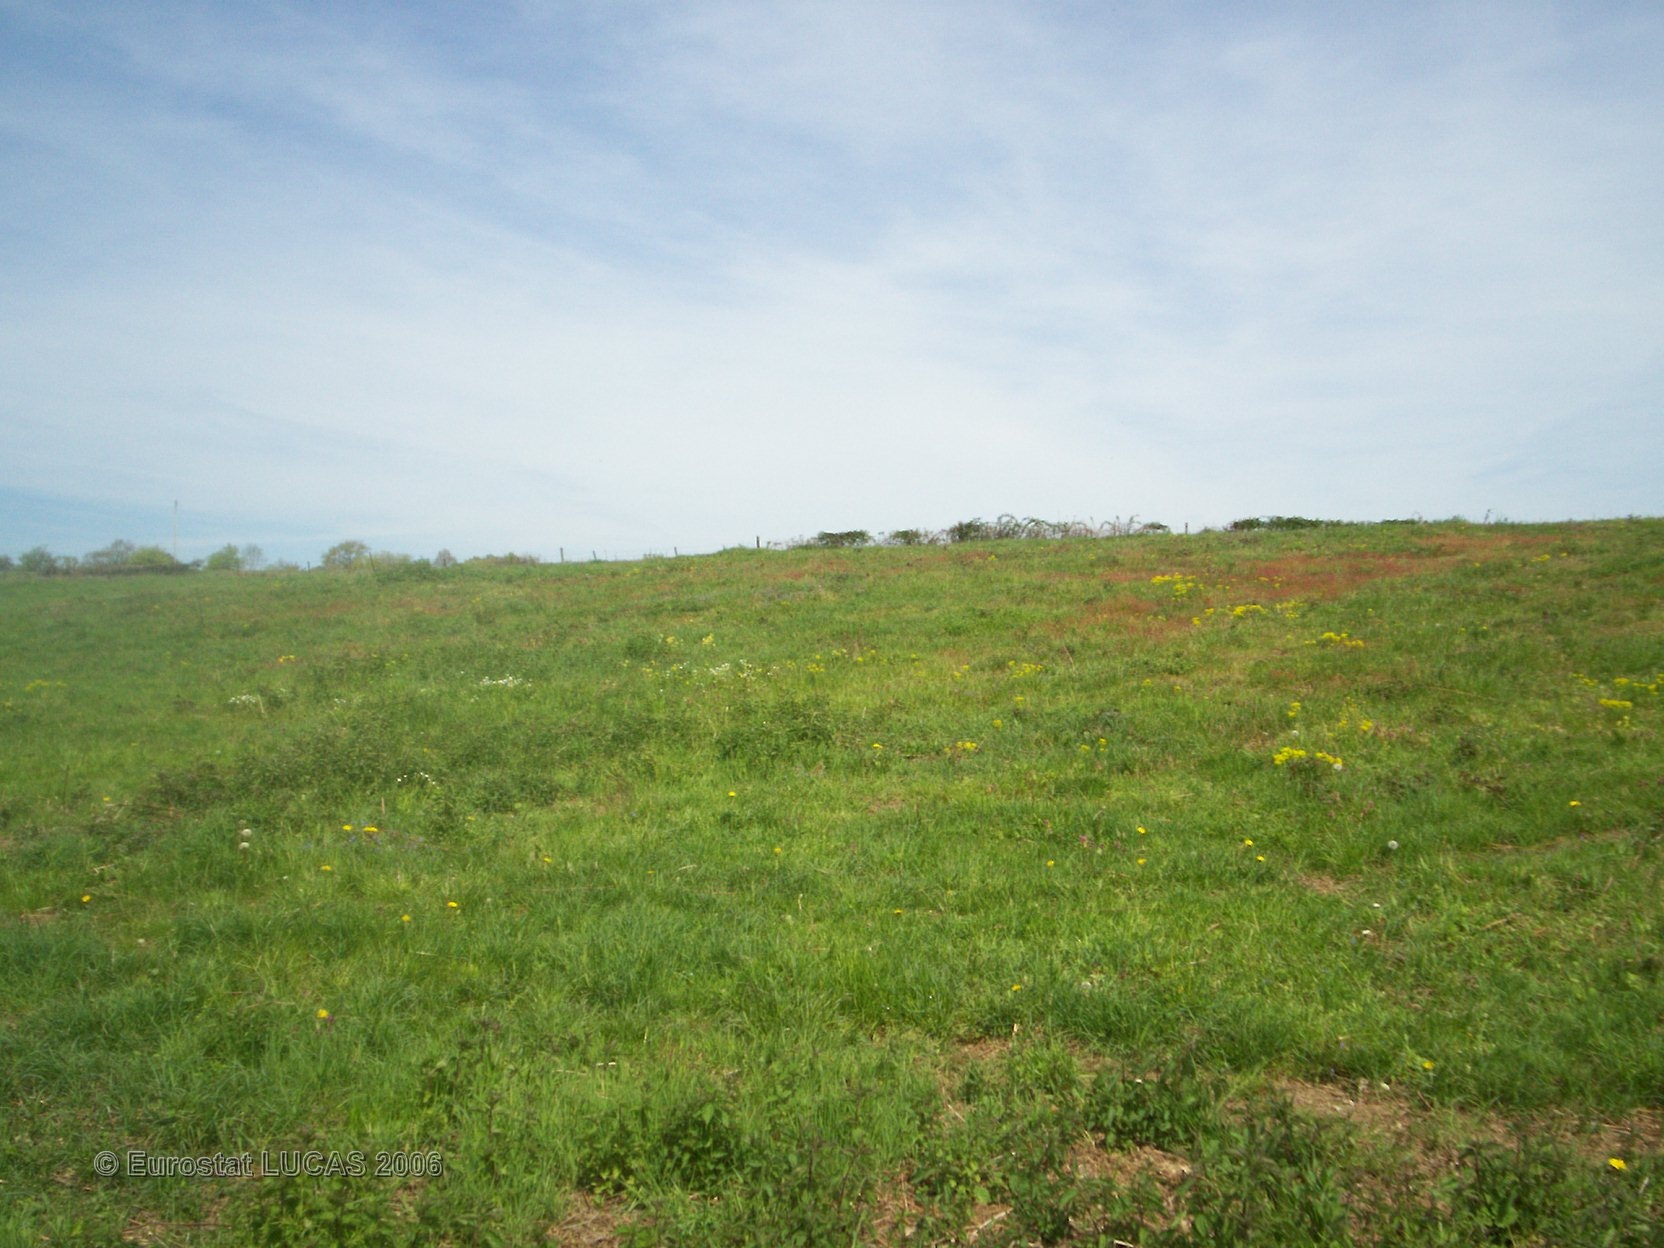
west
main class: Grassland
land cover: Grassland without tree/shrub cover
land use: Agriculture (excluding fallow land and kitchen gardens)
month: May
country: FR
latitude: 46.3826
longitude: 3.1197
